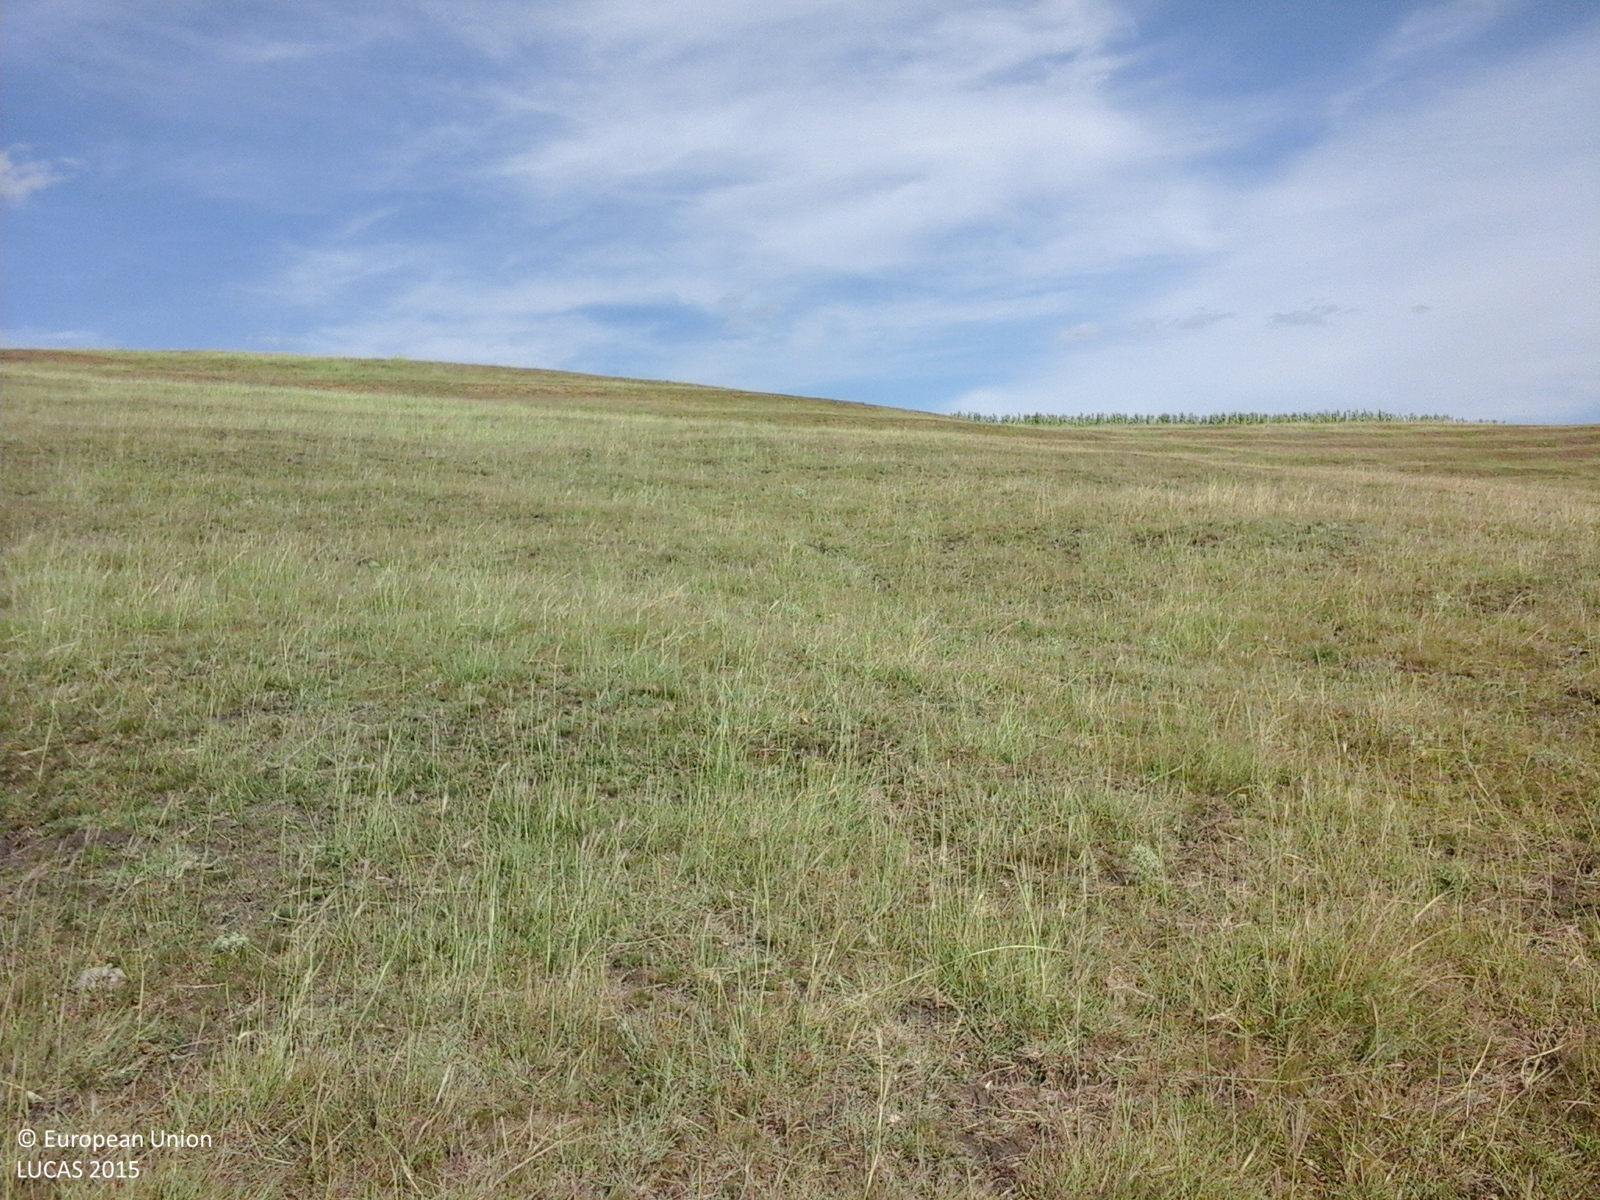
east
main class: Grassland
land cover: Grassland without tree/shrub cover
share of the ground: > 75 %
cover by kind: herbaceous plants 100 %
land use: Agriculture (excluding fallow land and kitchen gardens)
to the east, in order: Grassland without tree/shrub cover; Maize
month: July
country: RO
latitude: 46.0258
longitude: 27.6682
